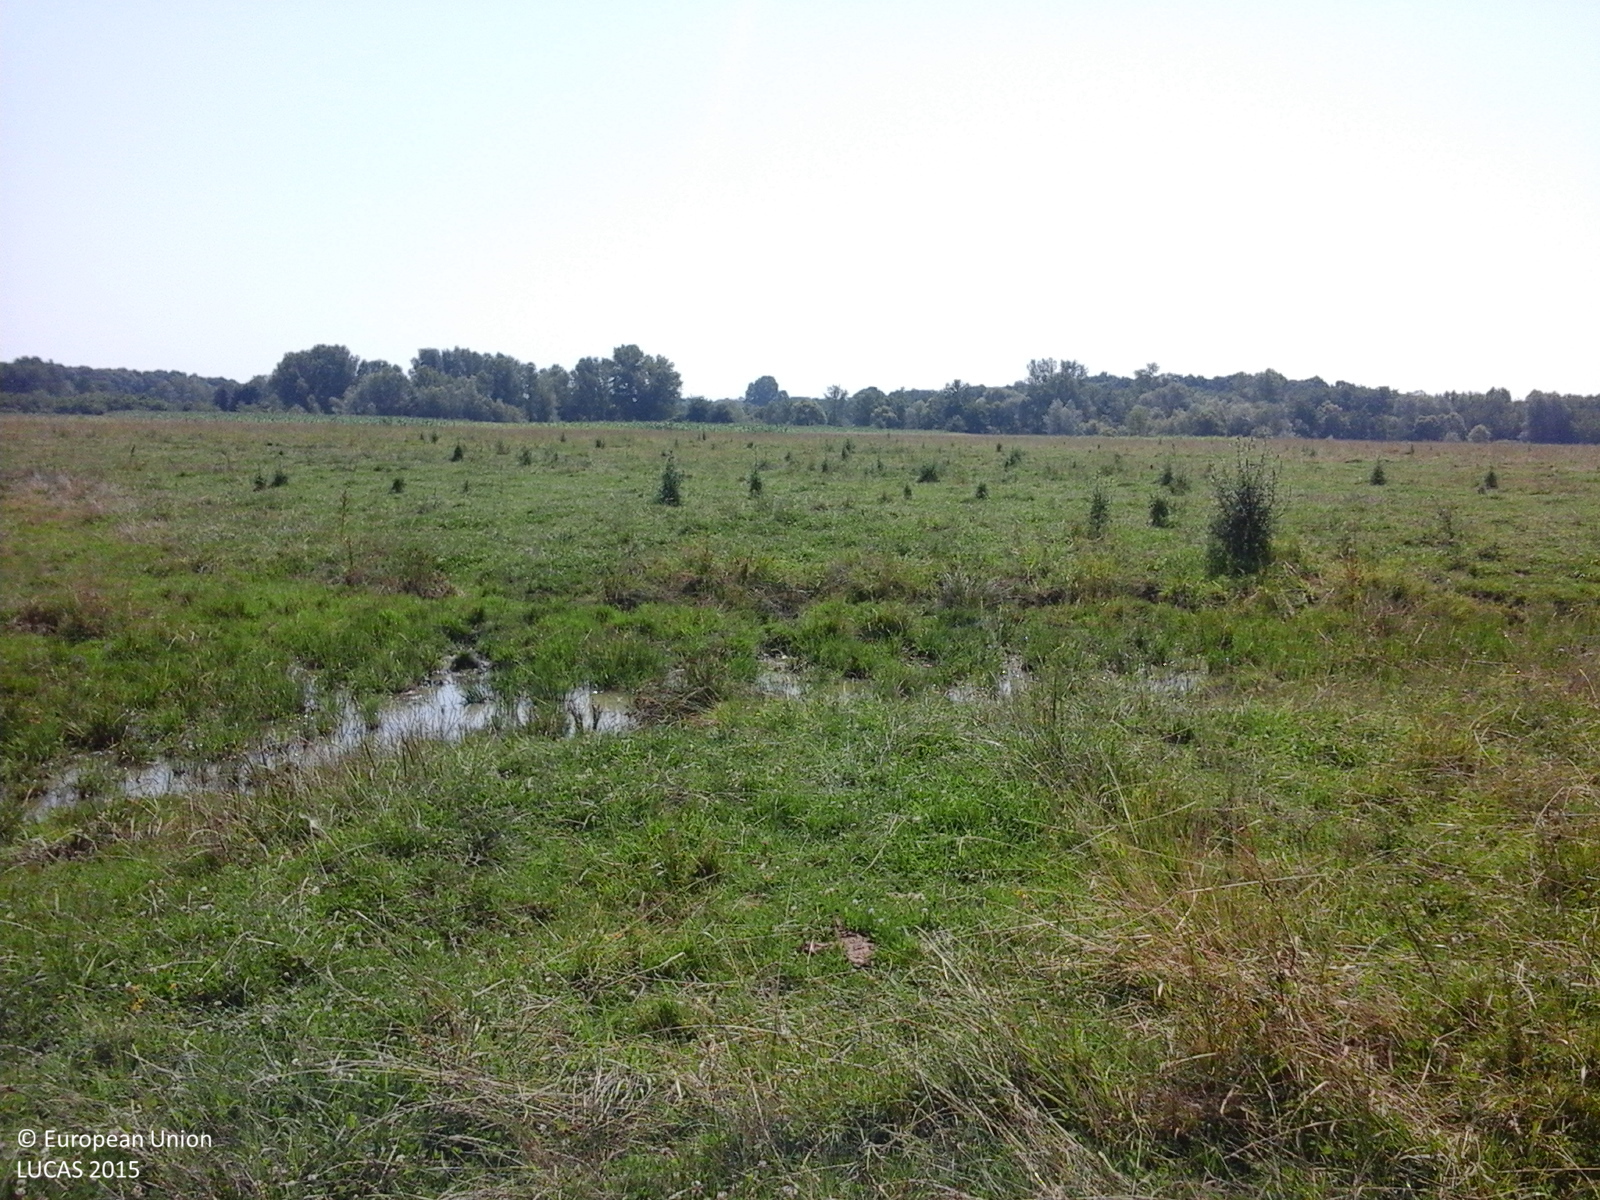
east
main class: Grassland
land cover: Grassland without tree/shrub cover
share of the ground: > 75 %
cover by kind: herbaceous plants 100 %
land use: Agriculture (excluding fallow land and kitchen gardens)
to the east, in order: Grassland without tree/shrub cover; Ditches and canals; Grassland without tree/shrub cover; Tracks; Grassland without tree/shrub cover; Maize; Common wheat
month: July
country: RO
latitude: 44.5396
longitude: 24.9694
